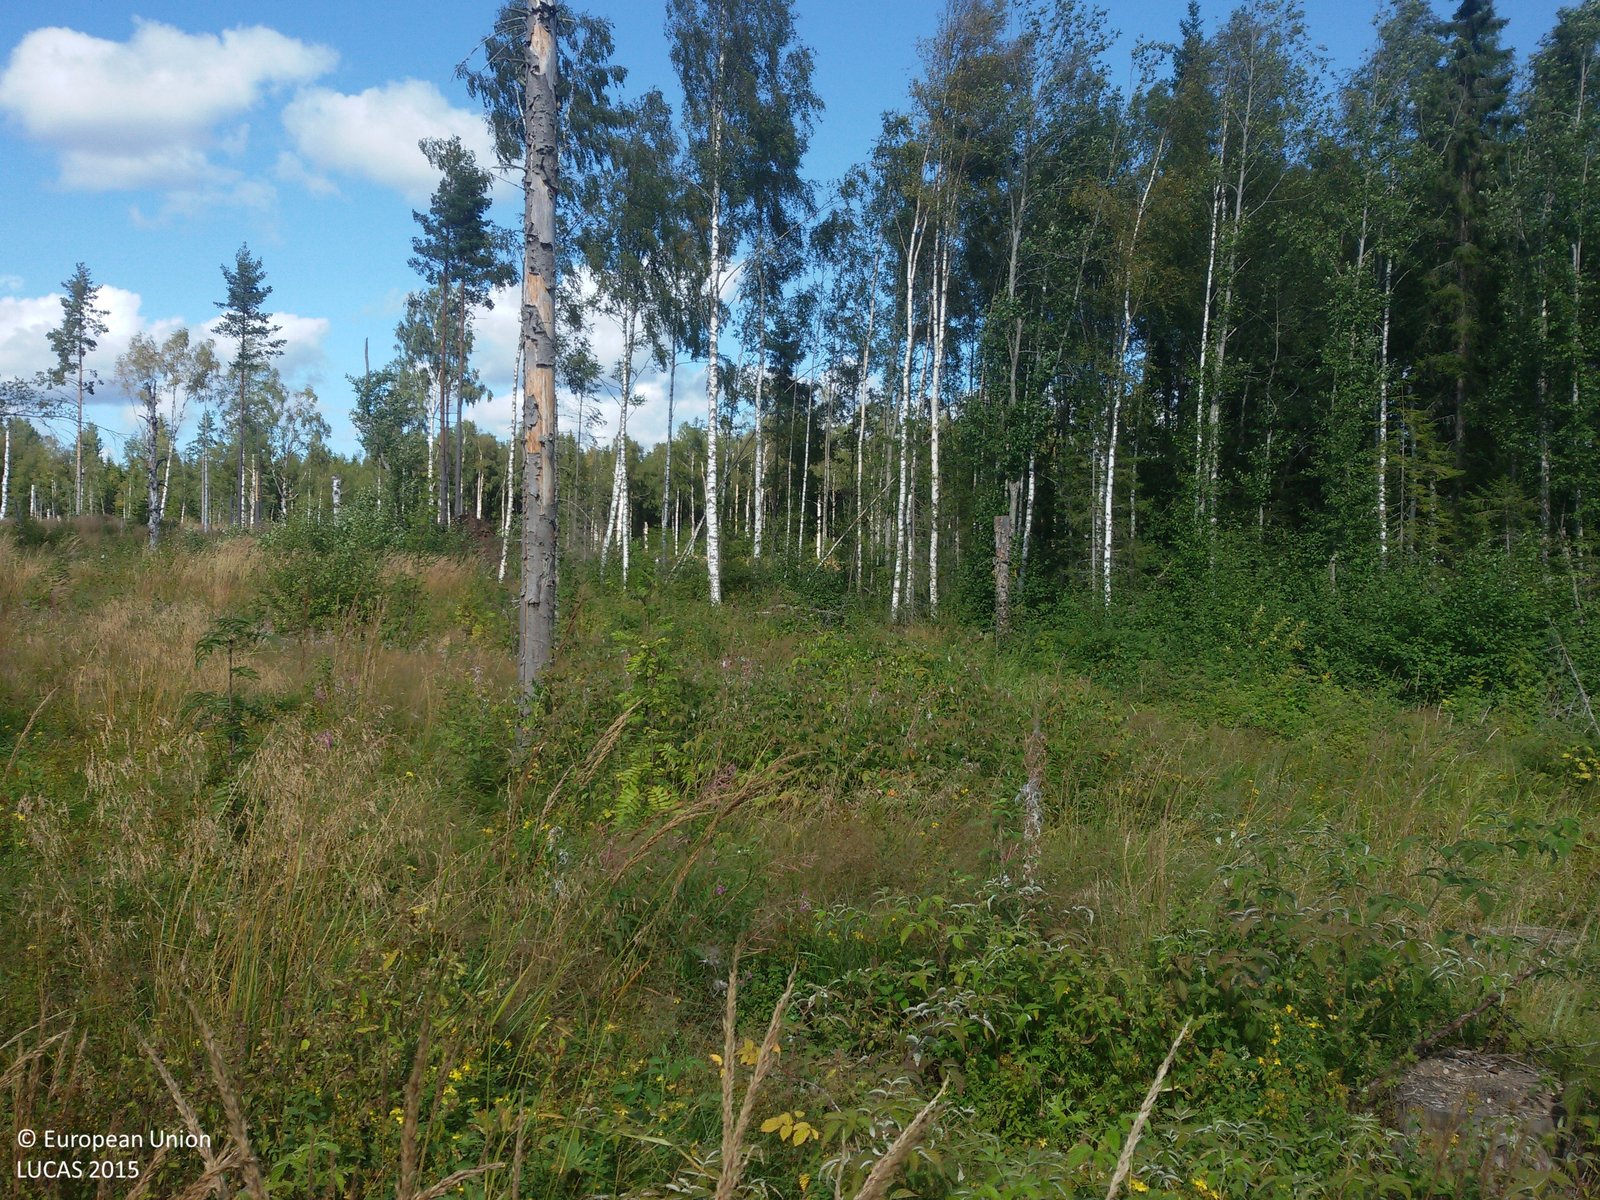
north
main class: Woodland
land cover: Broadleaved woodland
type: boreal forest
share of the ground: 10 - 25 %
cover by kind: herbaceous plants 60 %, shrubs 30 %, broadleaved forest trees 10 %
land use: Forestry
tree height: < 5 m
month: August
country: SE
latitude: 60.7923
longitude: 16.0309
